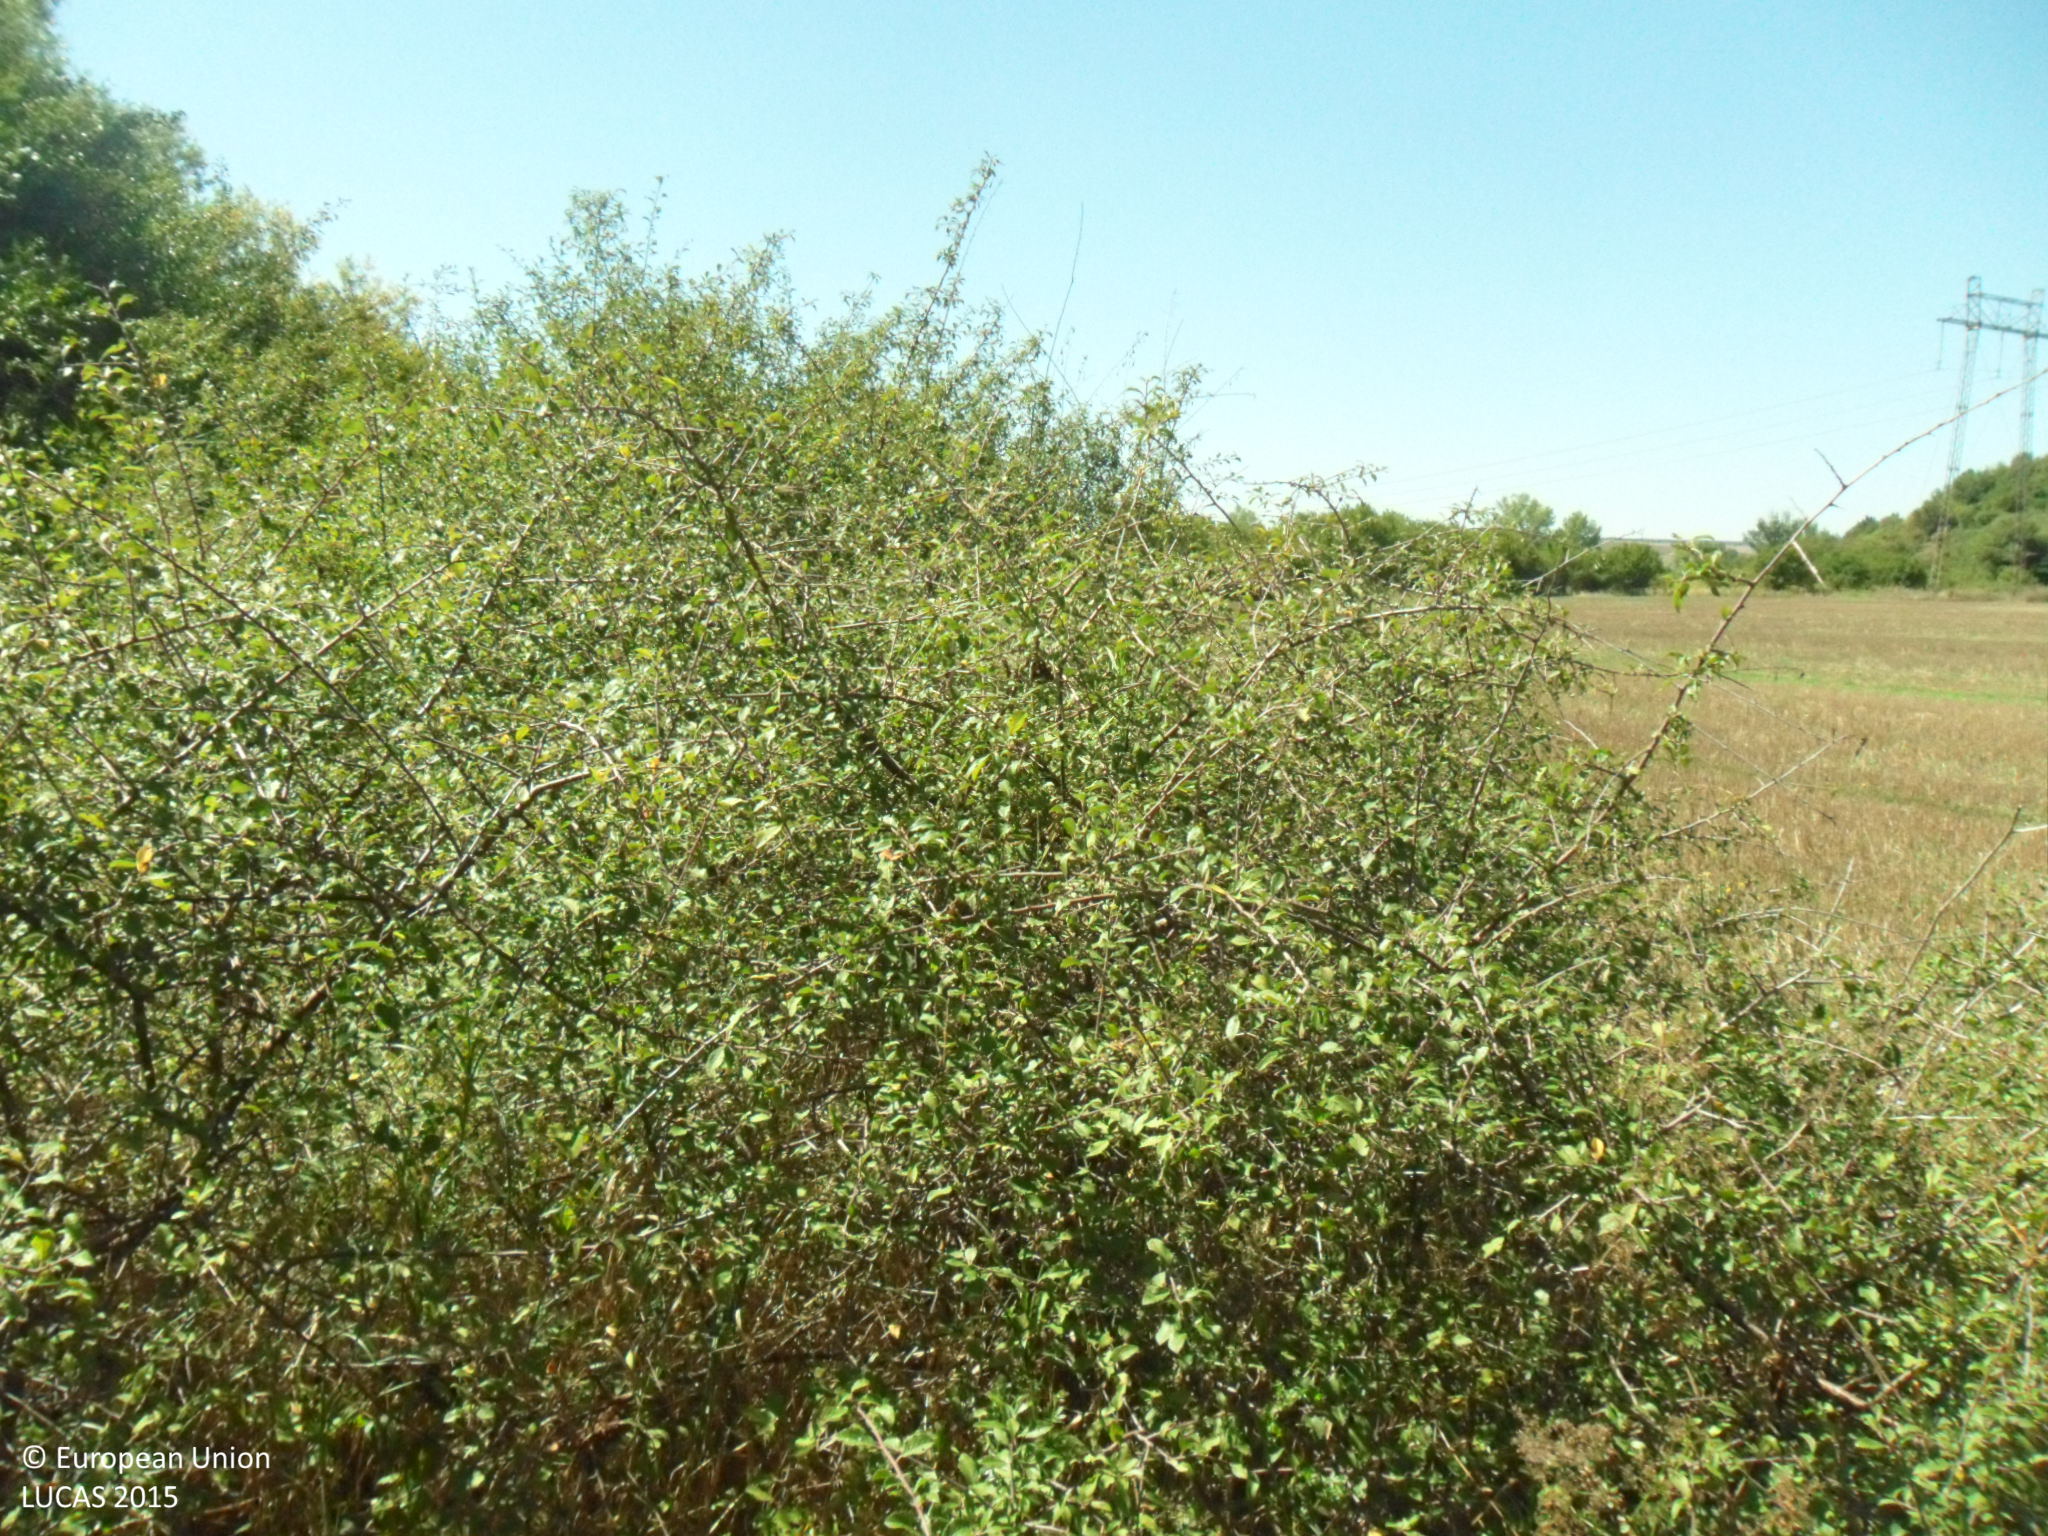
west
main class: Woodland
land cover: Broadleaved woodland
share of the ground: > 75 %
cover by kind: broadleaved forest trees 70 %, shrubs 25 %, herbaceous plants 5 %
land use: Semi-natural and natural areas not in use
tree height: > 5 m
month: September
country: BG
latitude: 43.2629
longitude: 26.8021
